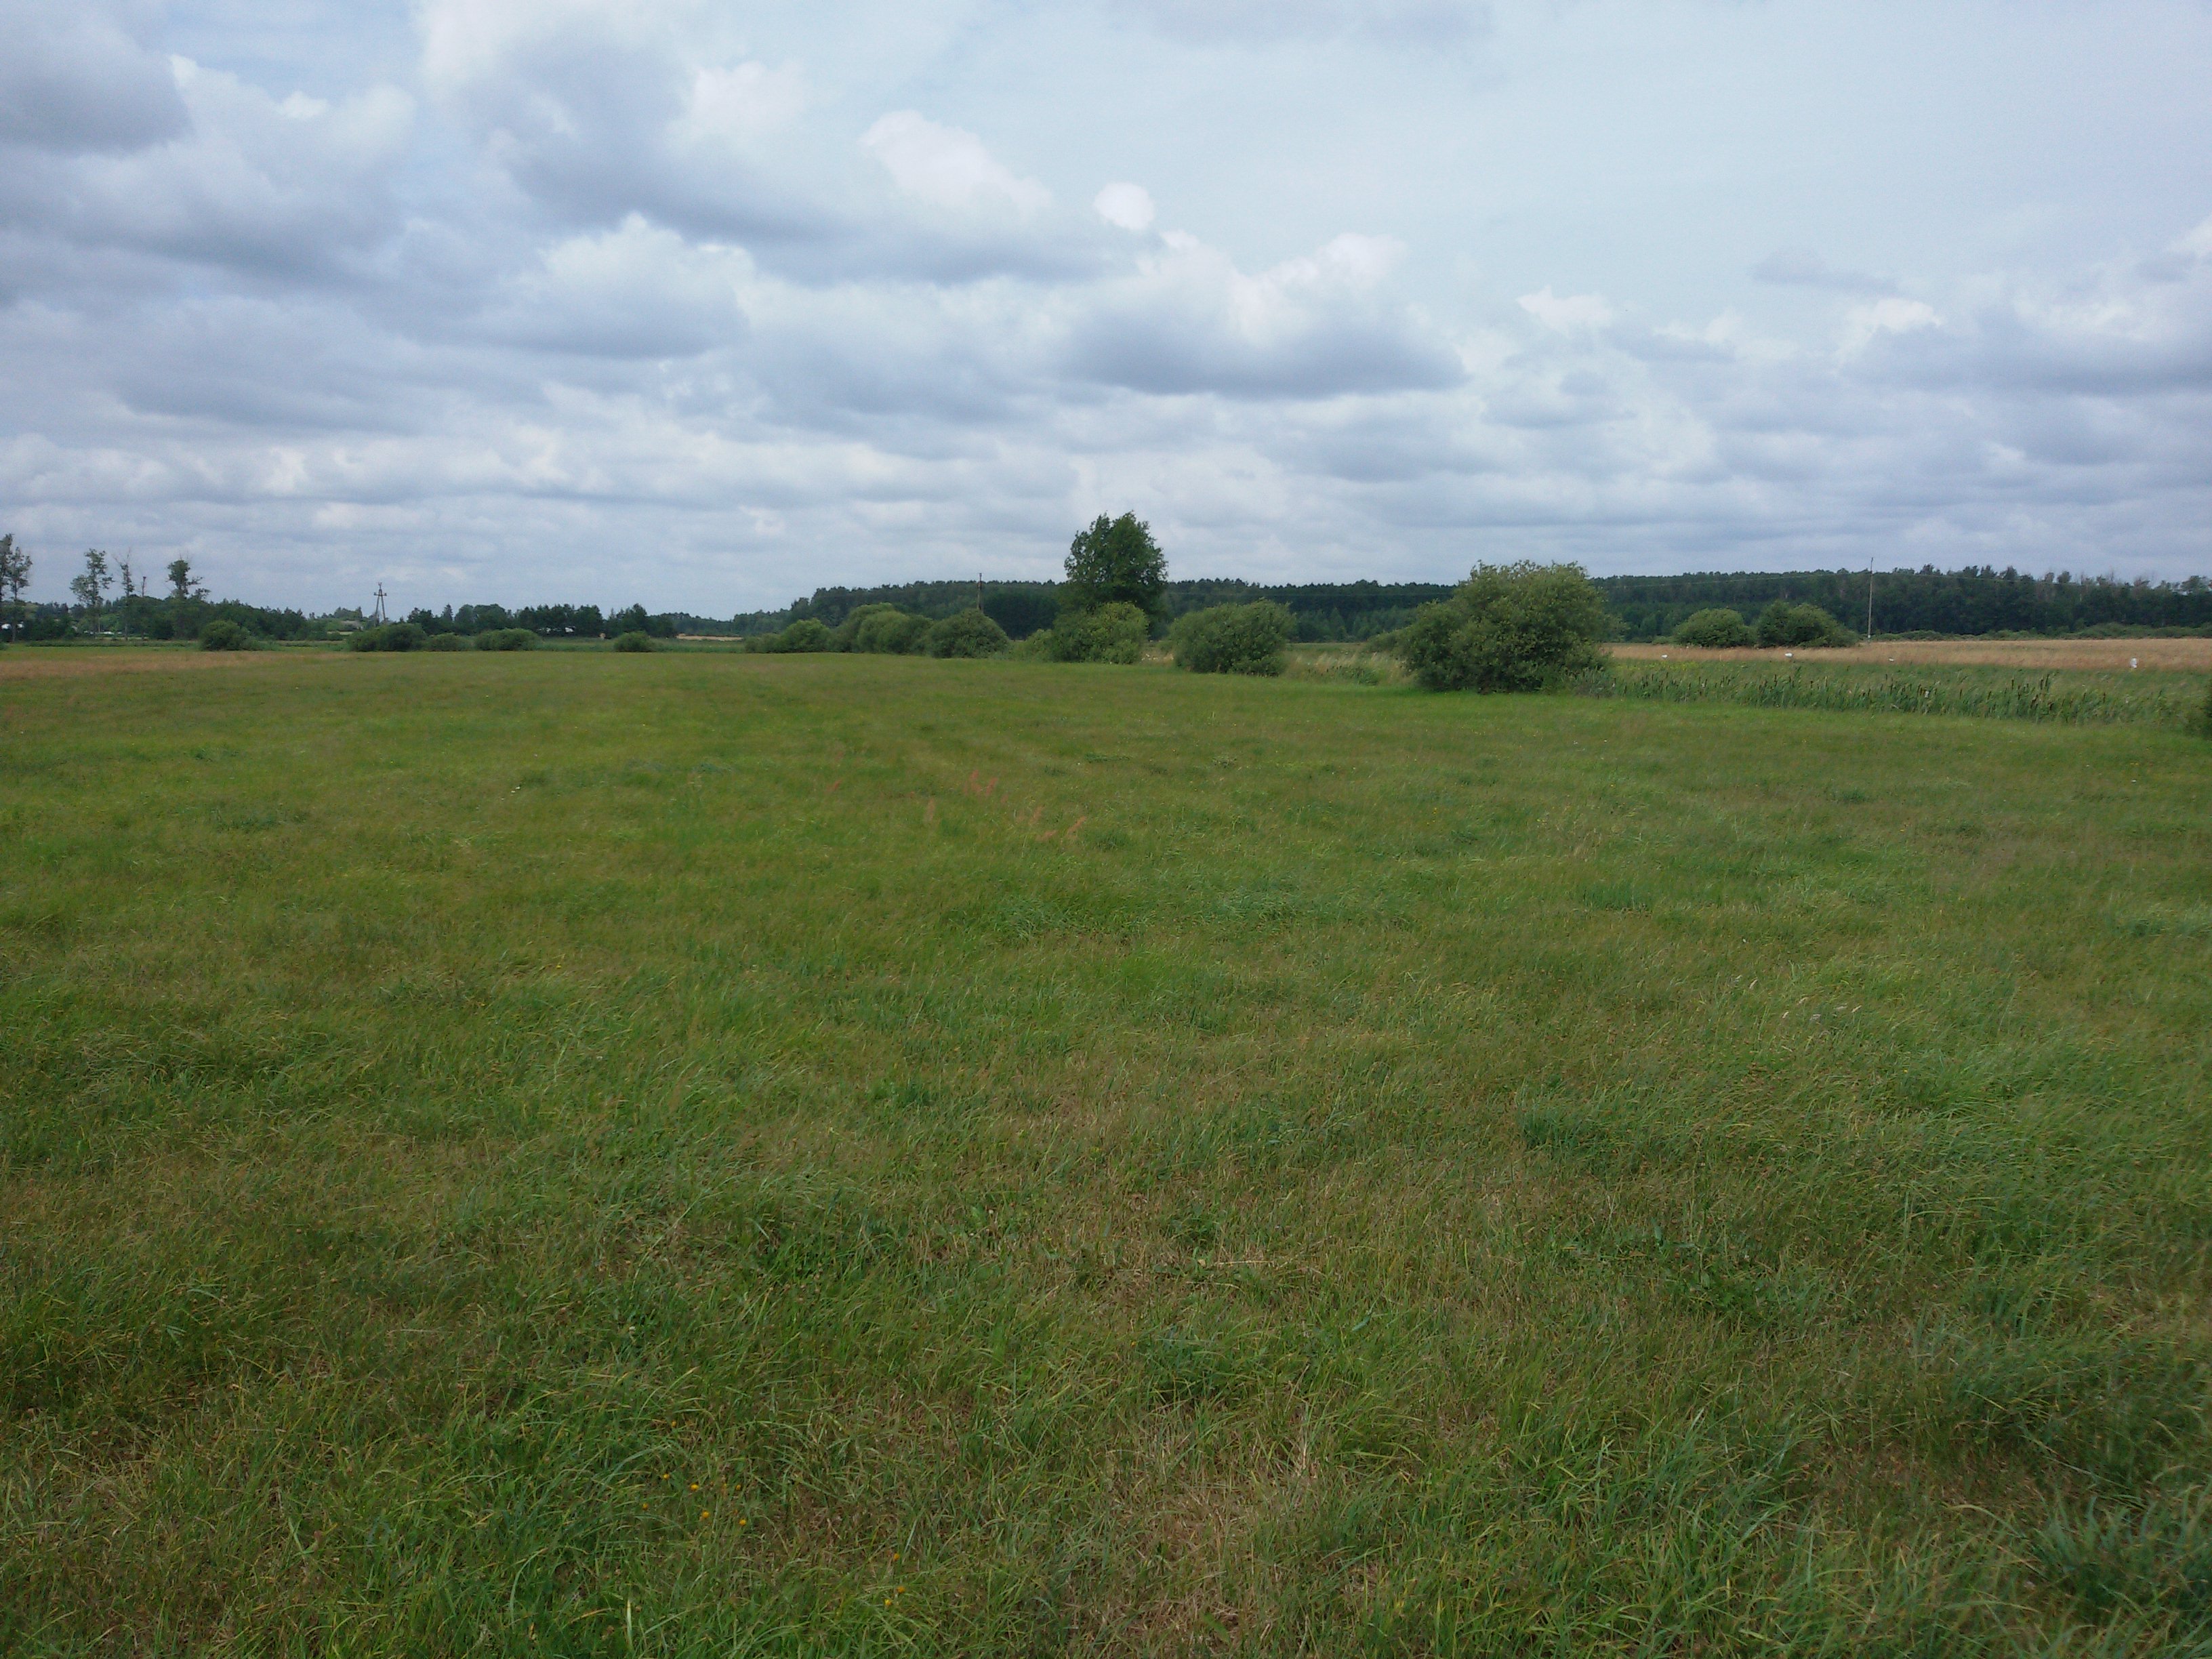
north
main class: Cropland
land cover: Triticale
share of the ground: > 75 %
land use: Agriculture (excluding fallow land and kitchen gardens)
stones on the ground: < 10 %
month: July
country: PL
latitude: 51.8881
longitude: 22.9030
